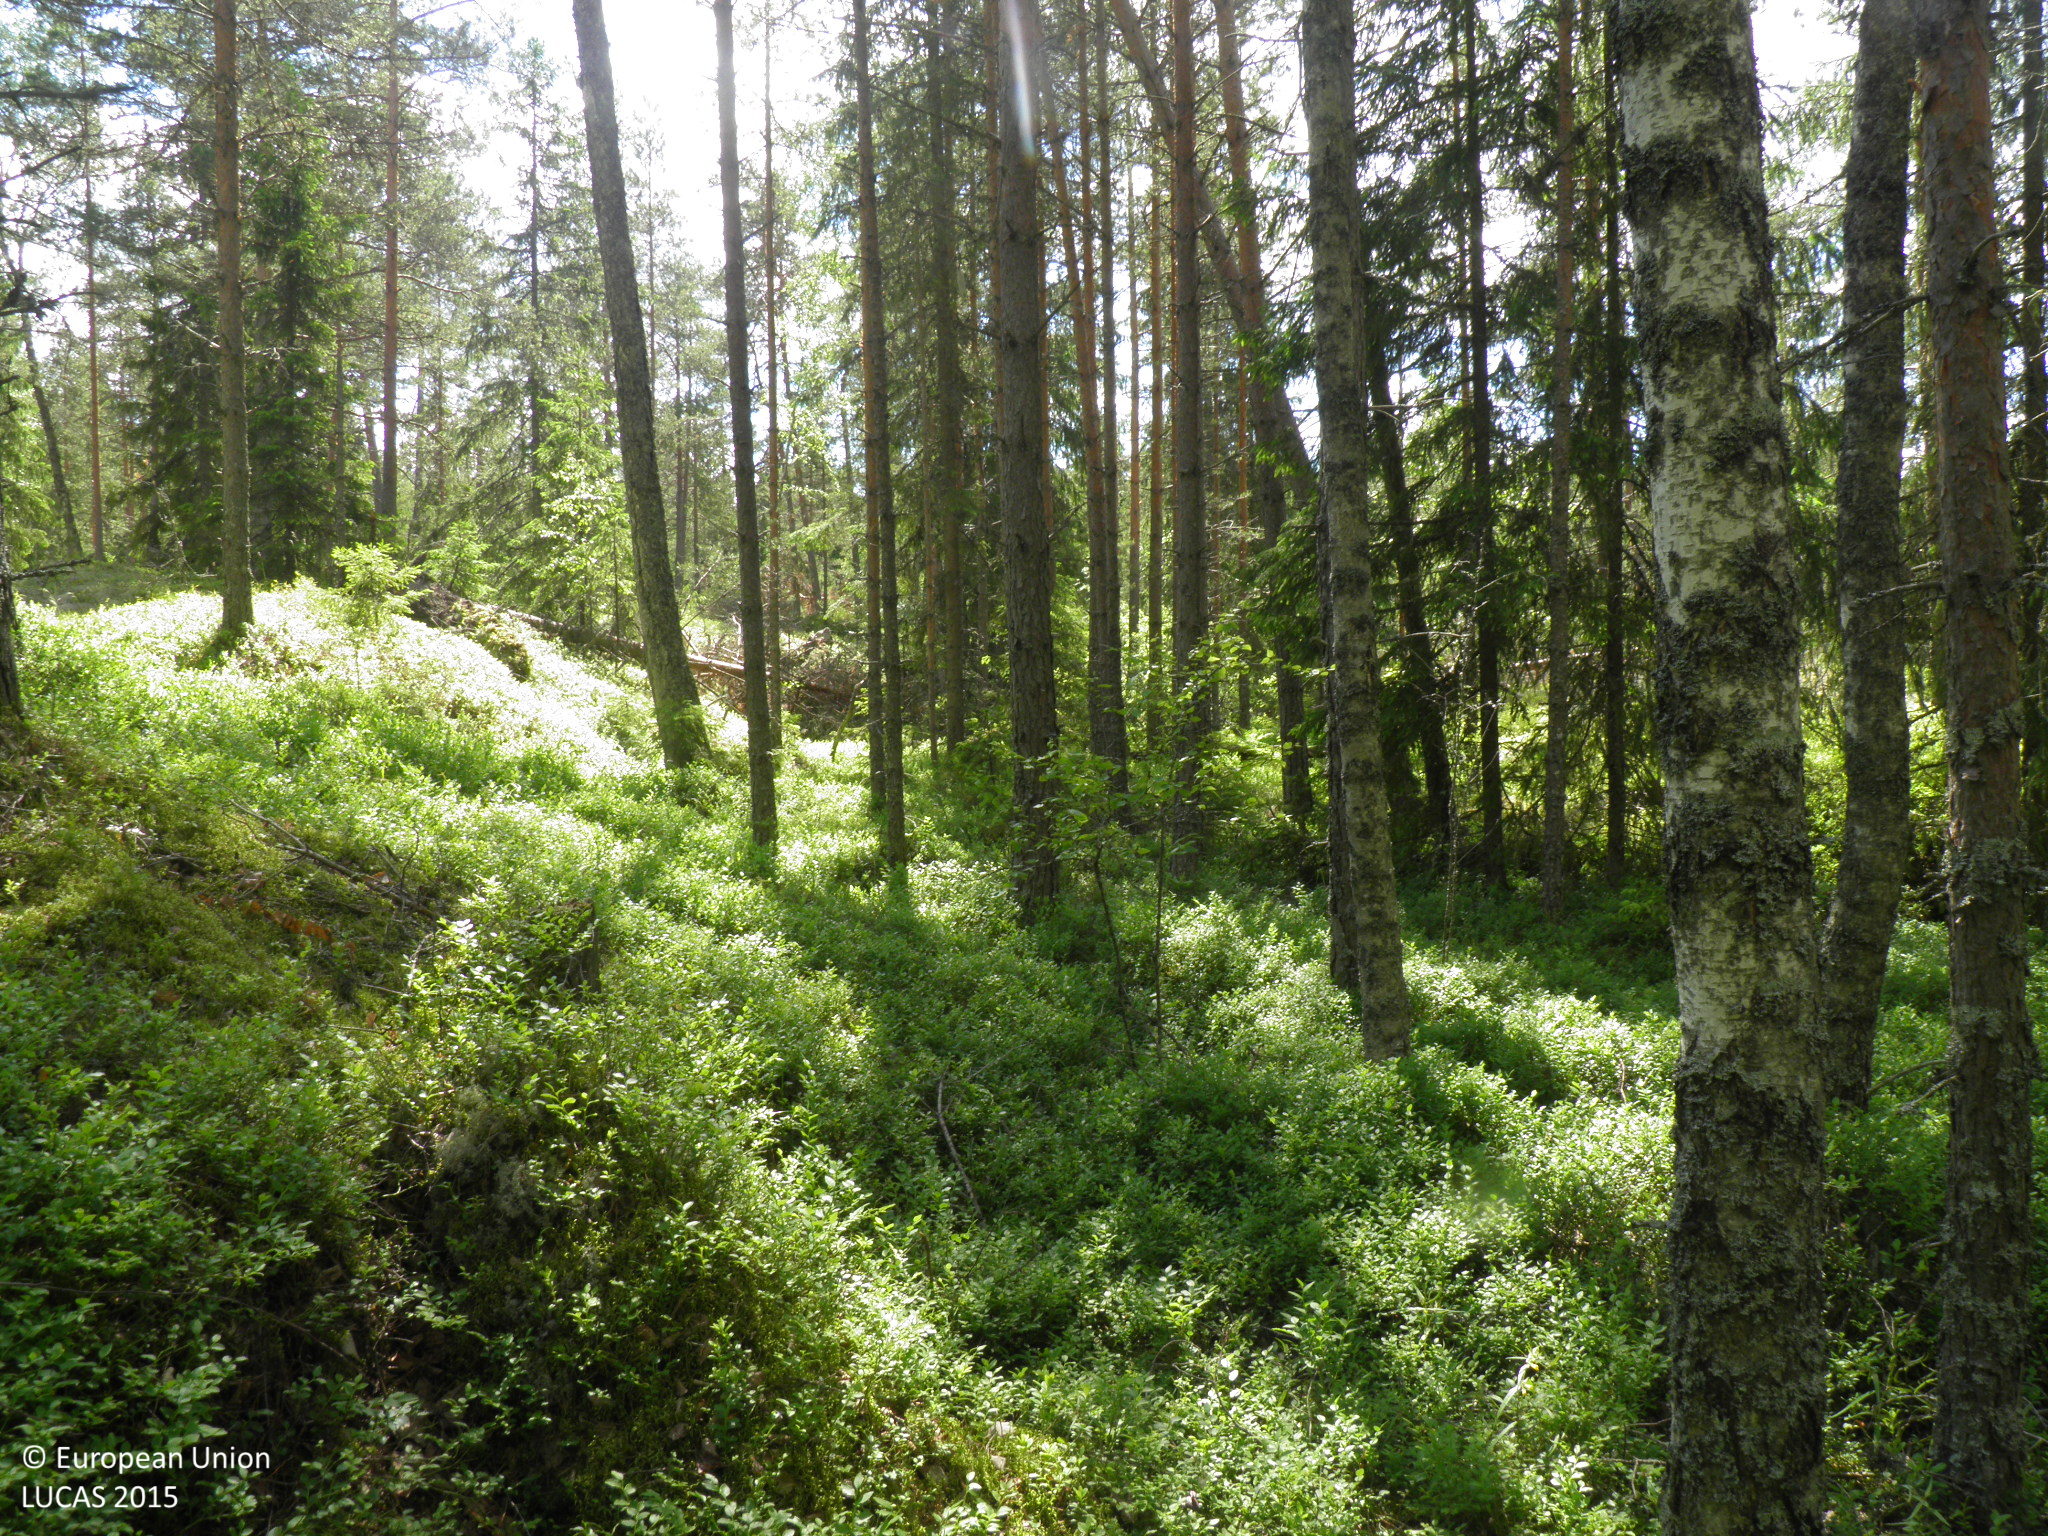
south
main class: Woodland
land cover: Pine dominated mixed woodland
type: hemiboreal forest and nemoral coniferous forest and mixed broadleaved-coniferous forest
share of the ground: 50 - 75 %
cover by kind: coniferous forest trees 40 %, broadleaved forest trees 30 %, shrubs 20 %, herbaceous plants 10 %
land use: Forestry
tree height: > 5 m
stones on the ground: > 50 %
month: June
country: FI
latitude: 60.4981
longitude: 22.9108
